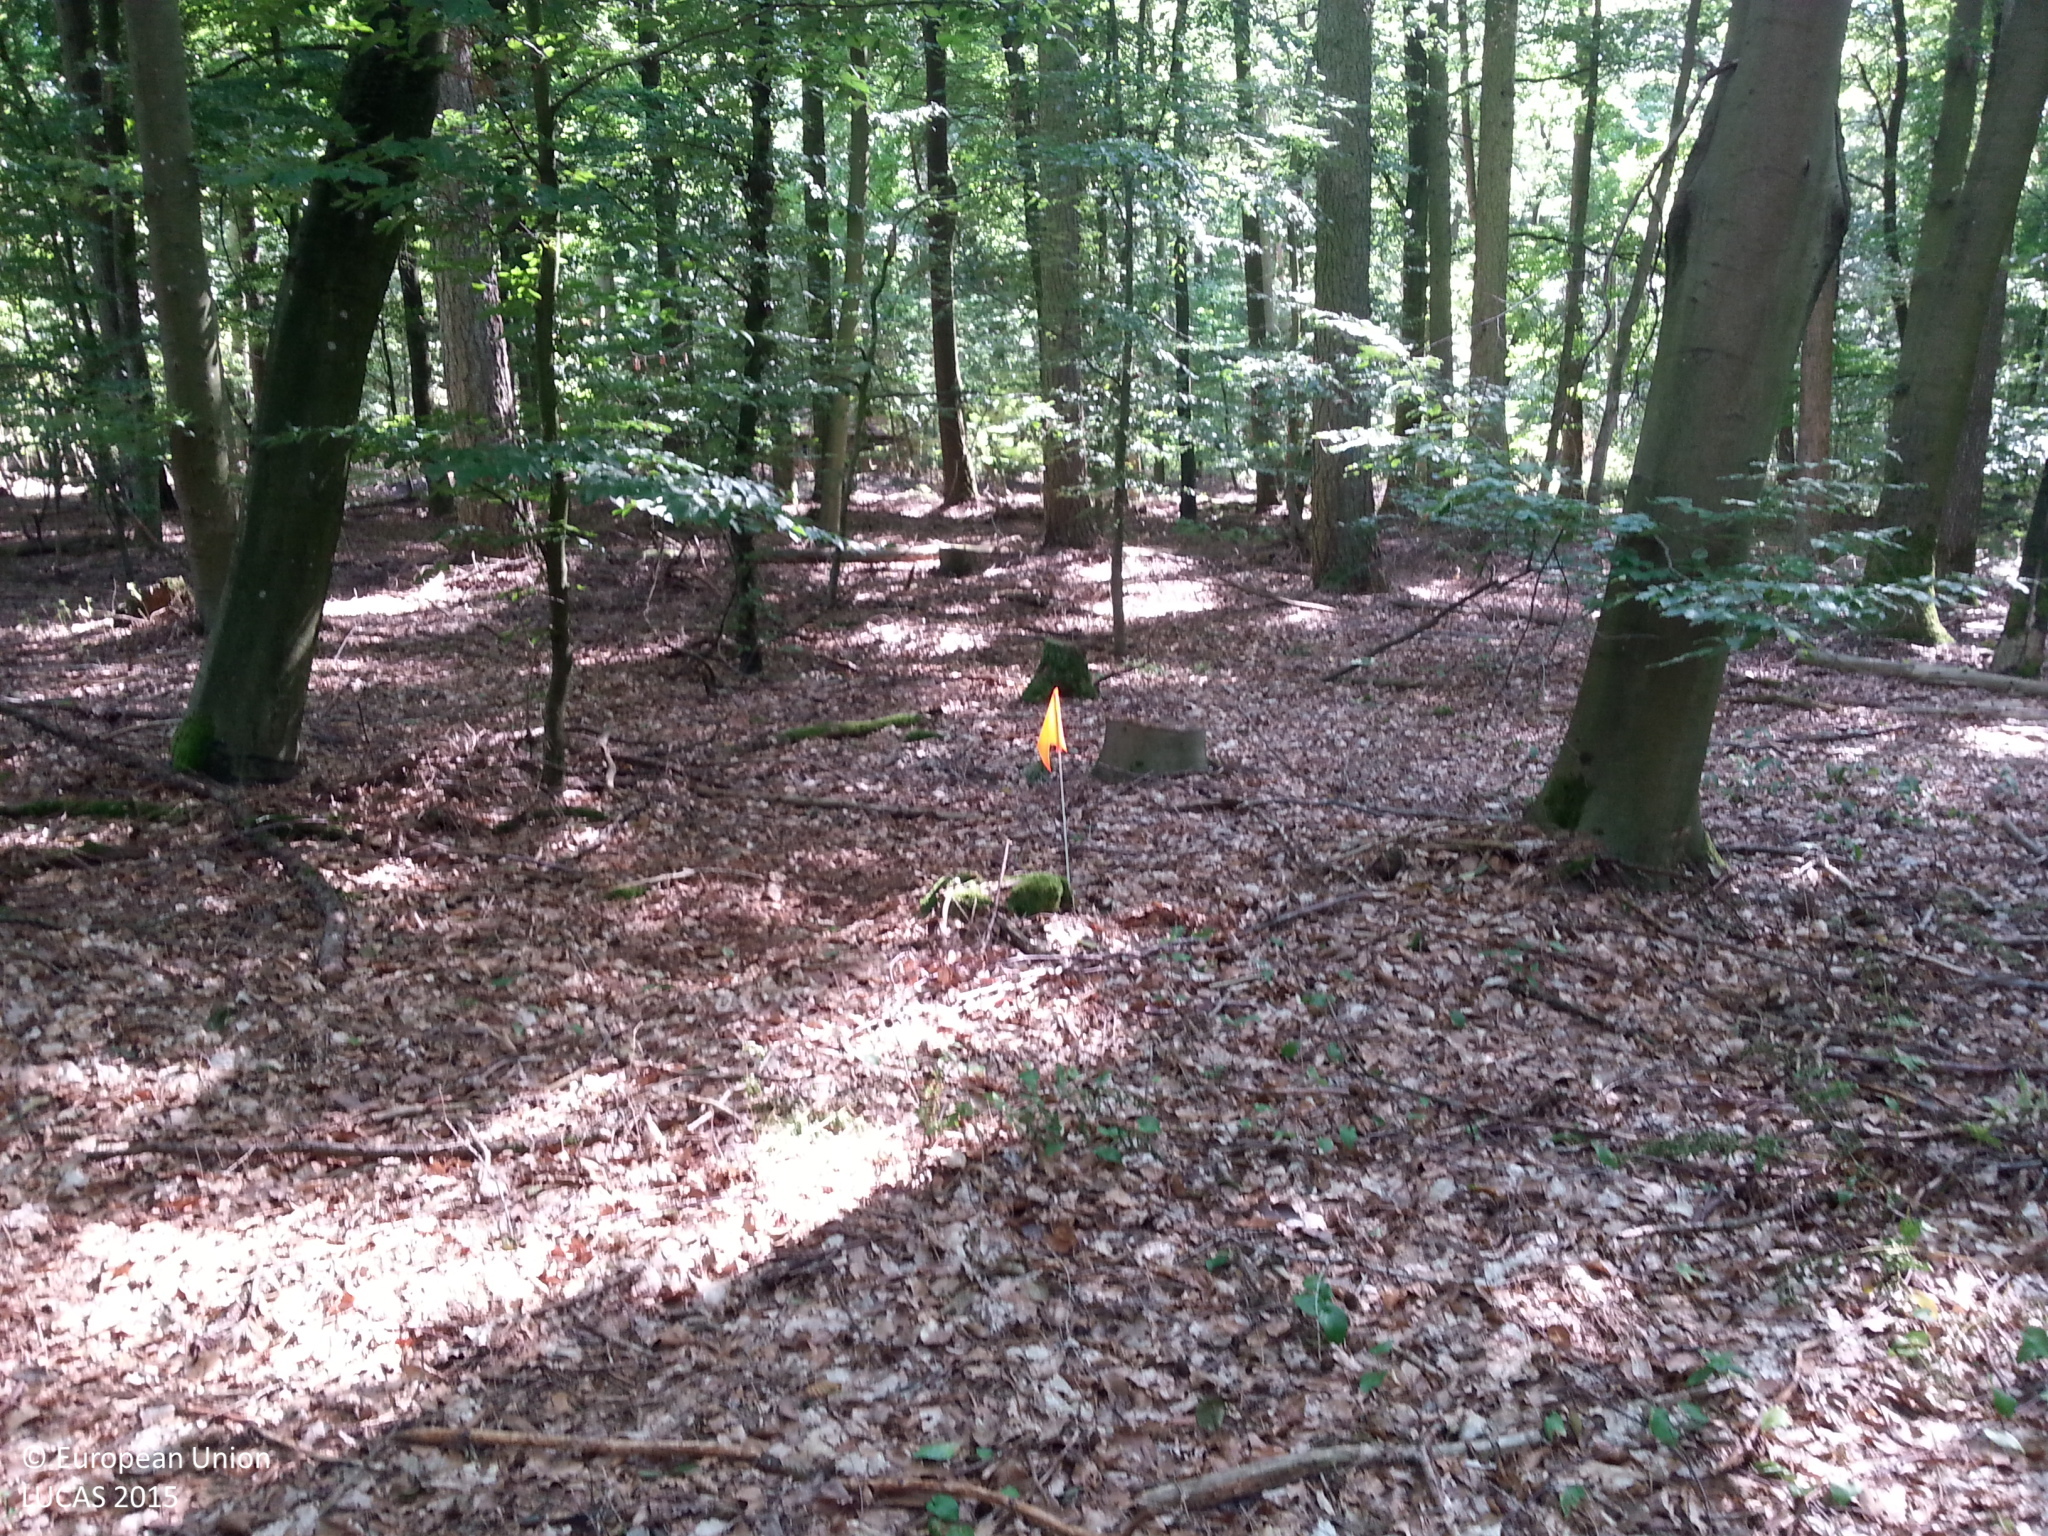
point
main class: Woodland
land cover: Other mixed woodland
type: hemiboreal forest and nemoral coniferous forest and mixed broadleaved-coniferous forest
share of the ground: > 75 %
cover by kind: broadleaved forest trees 50 %, coniferous forest trees 40 %, unconsolidated bare surface 10 %
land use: Forestry
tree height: > 5 m
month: August
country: DE
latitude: 49.4649
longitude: 9.9586
